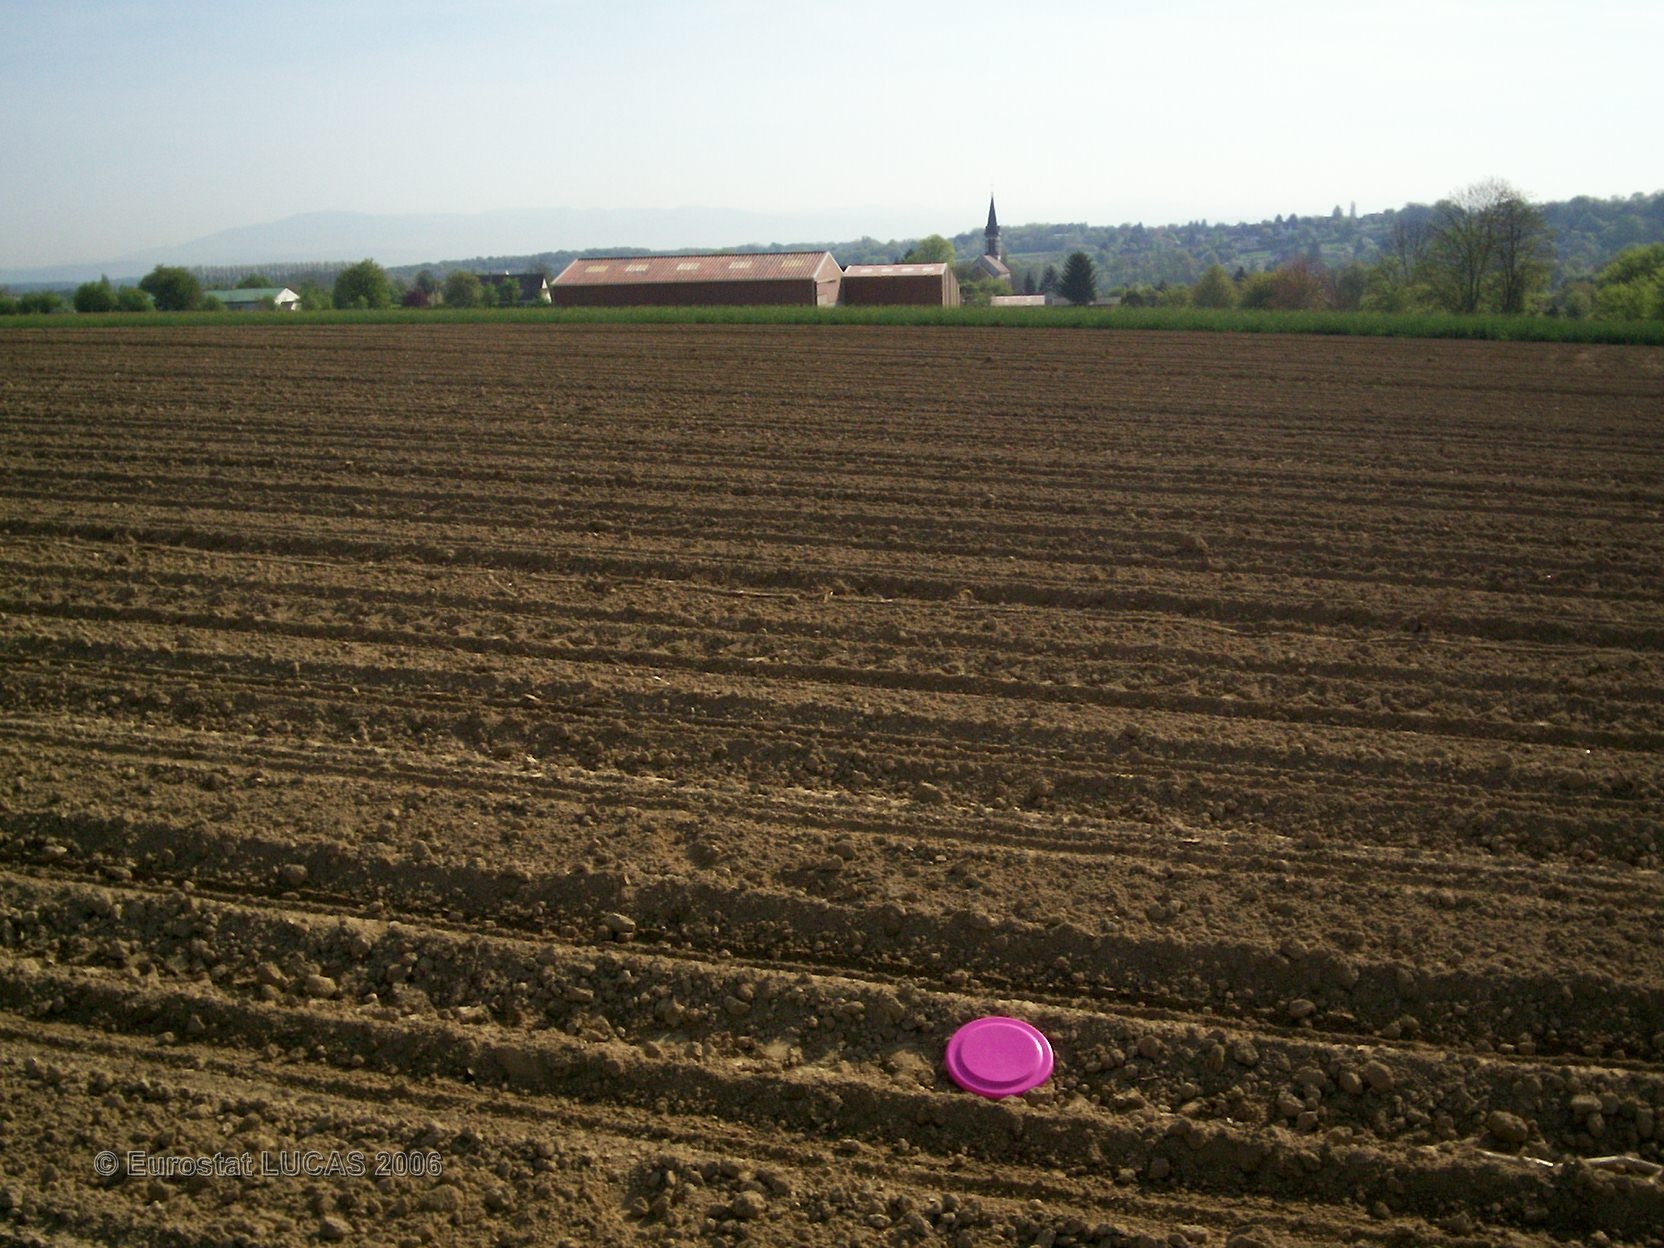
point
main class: Cropland
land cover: Maize
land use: Agriculture (excluding fallow land and kitchen gardens)
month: May
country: FR
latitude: 47.5635
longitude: 7.4364
